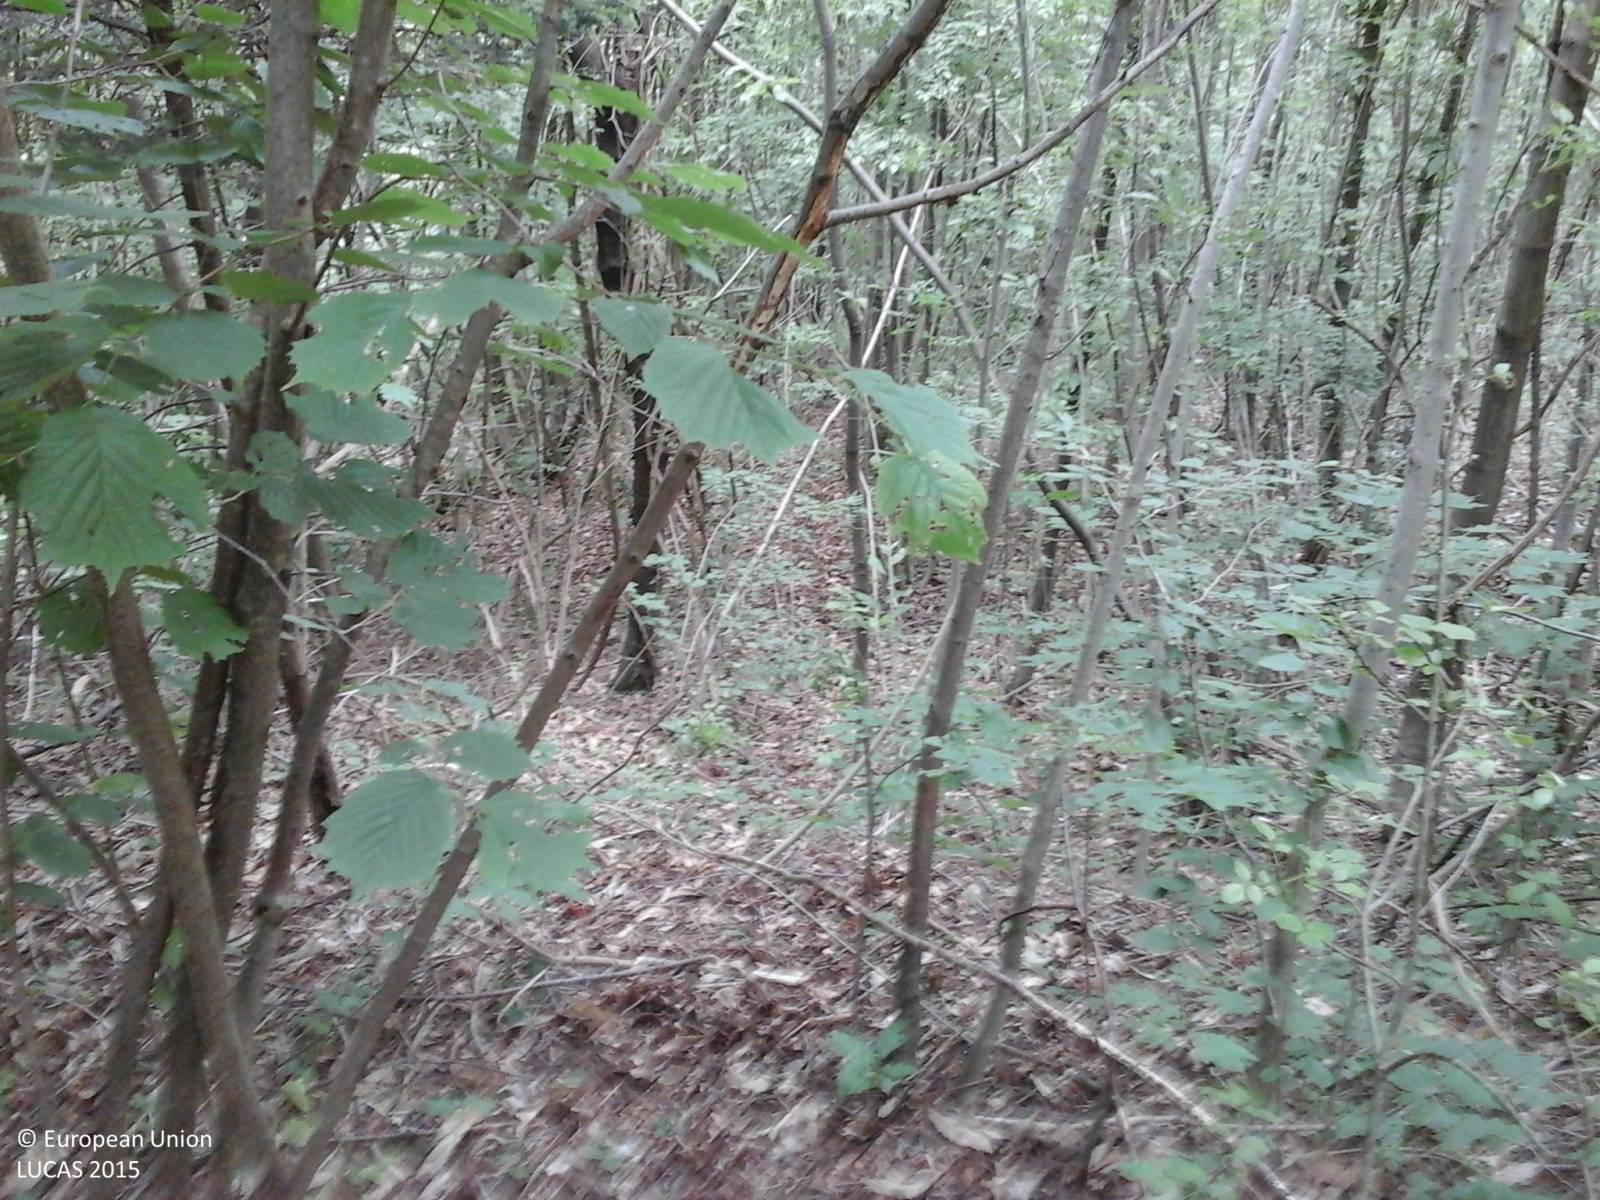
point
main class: Woodland
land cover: Broadleaved woodland
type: thermophilous deciduous forest
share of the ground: > 75 %
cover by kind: broadleaved forest trees 90 %, shrubs 10 %
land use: Forestry
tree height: > 5 m
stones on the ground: 10 - 25 %
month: June
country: IT
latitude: 46.1333
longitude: 13.4524
